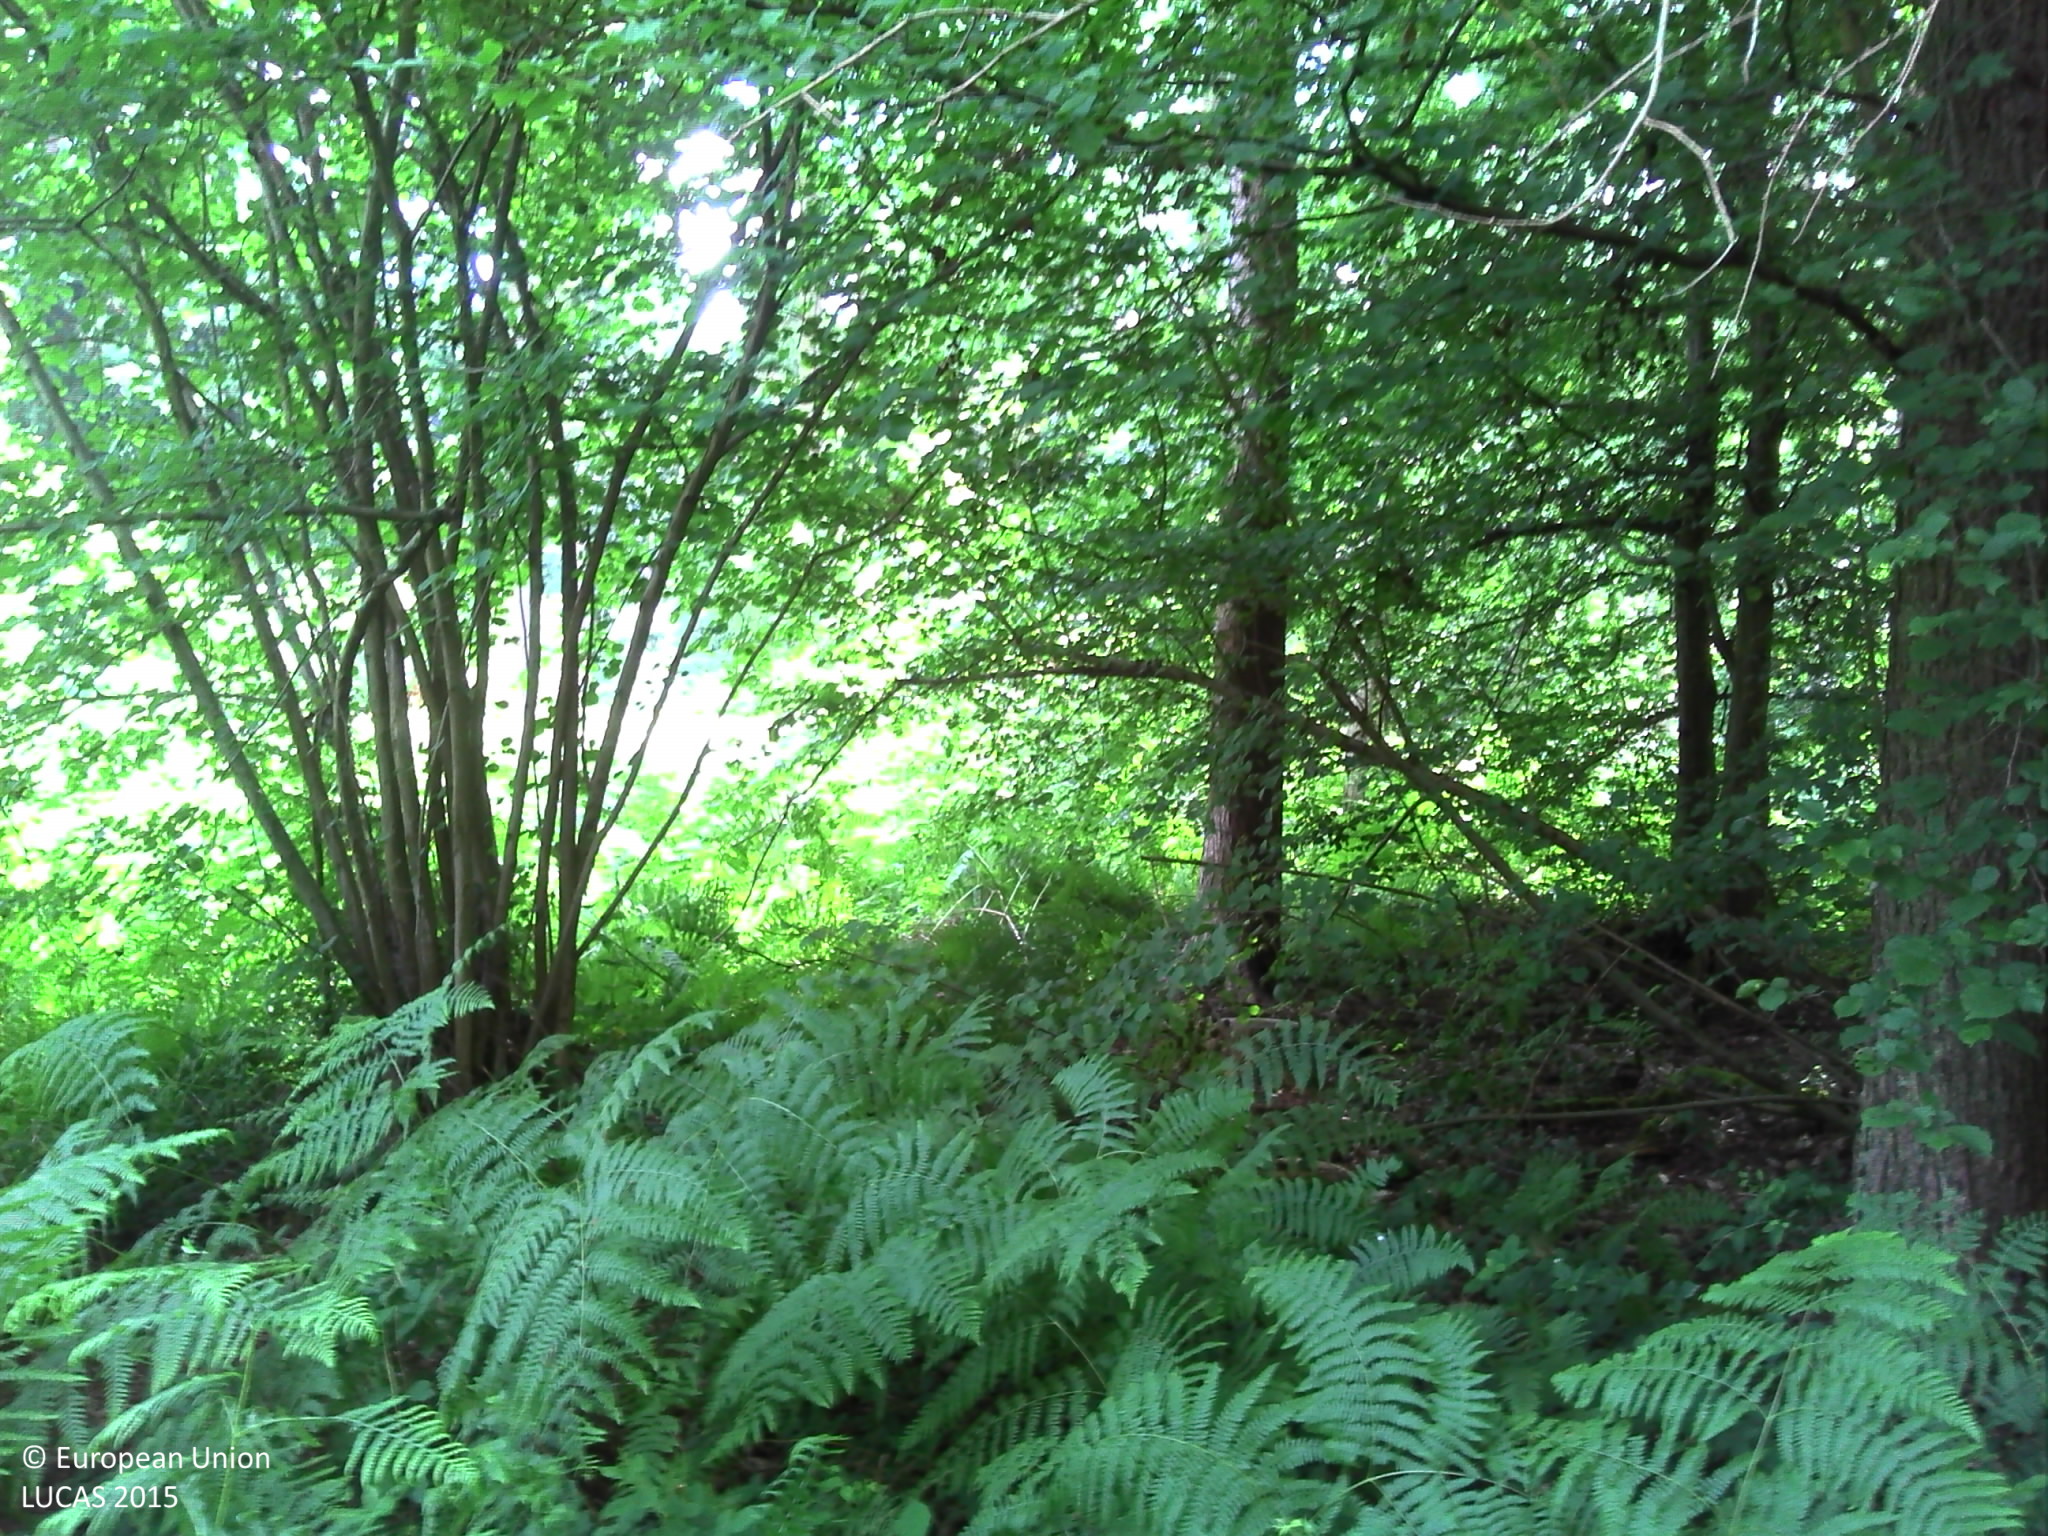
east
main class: Woodland
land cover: Spruce dominated mixed woodland
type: mesophytic deciduous forest
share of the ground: > 75 %
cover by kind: broadleaved forest trees 50 %, coniferous forest trees 40 %, herbaceous plants 10 %
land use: Forestry
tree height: > 5 m
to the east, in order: Spruce dominated mixed woodland; Tracks; Broadleaved woodland
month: June
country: FR
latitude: 49.2422
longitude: 1.1471
